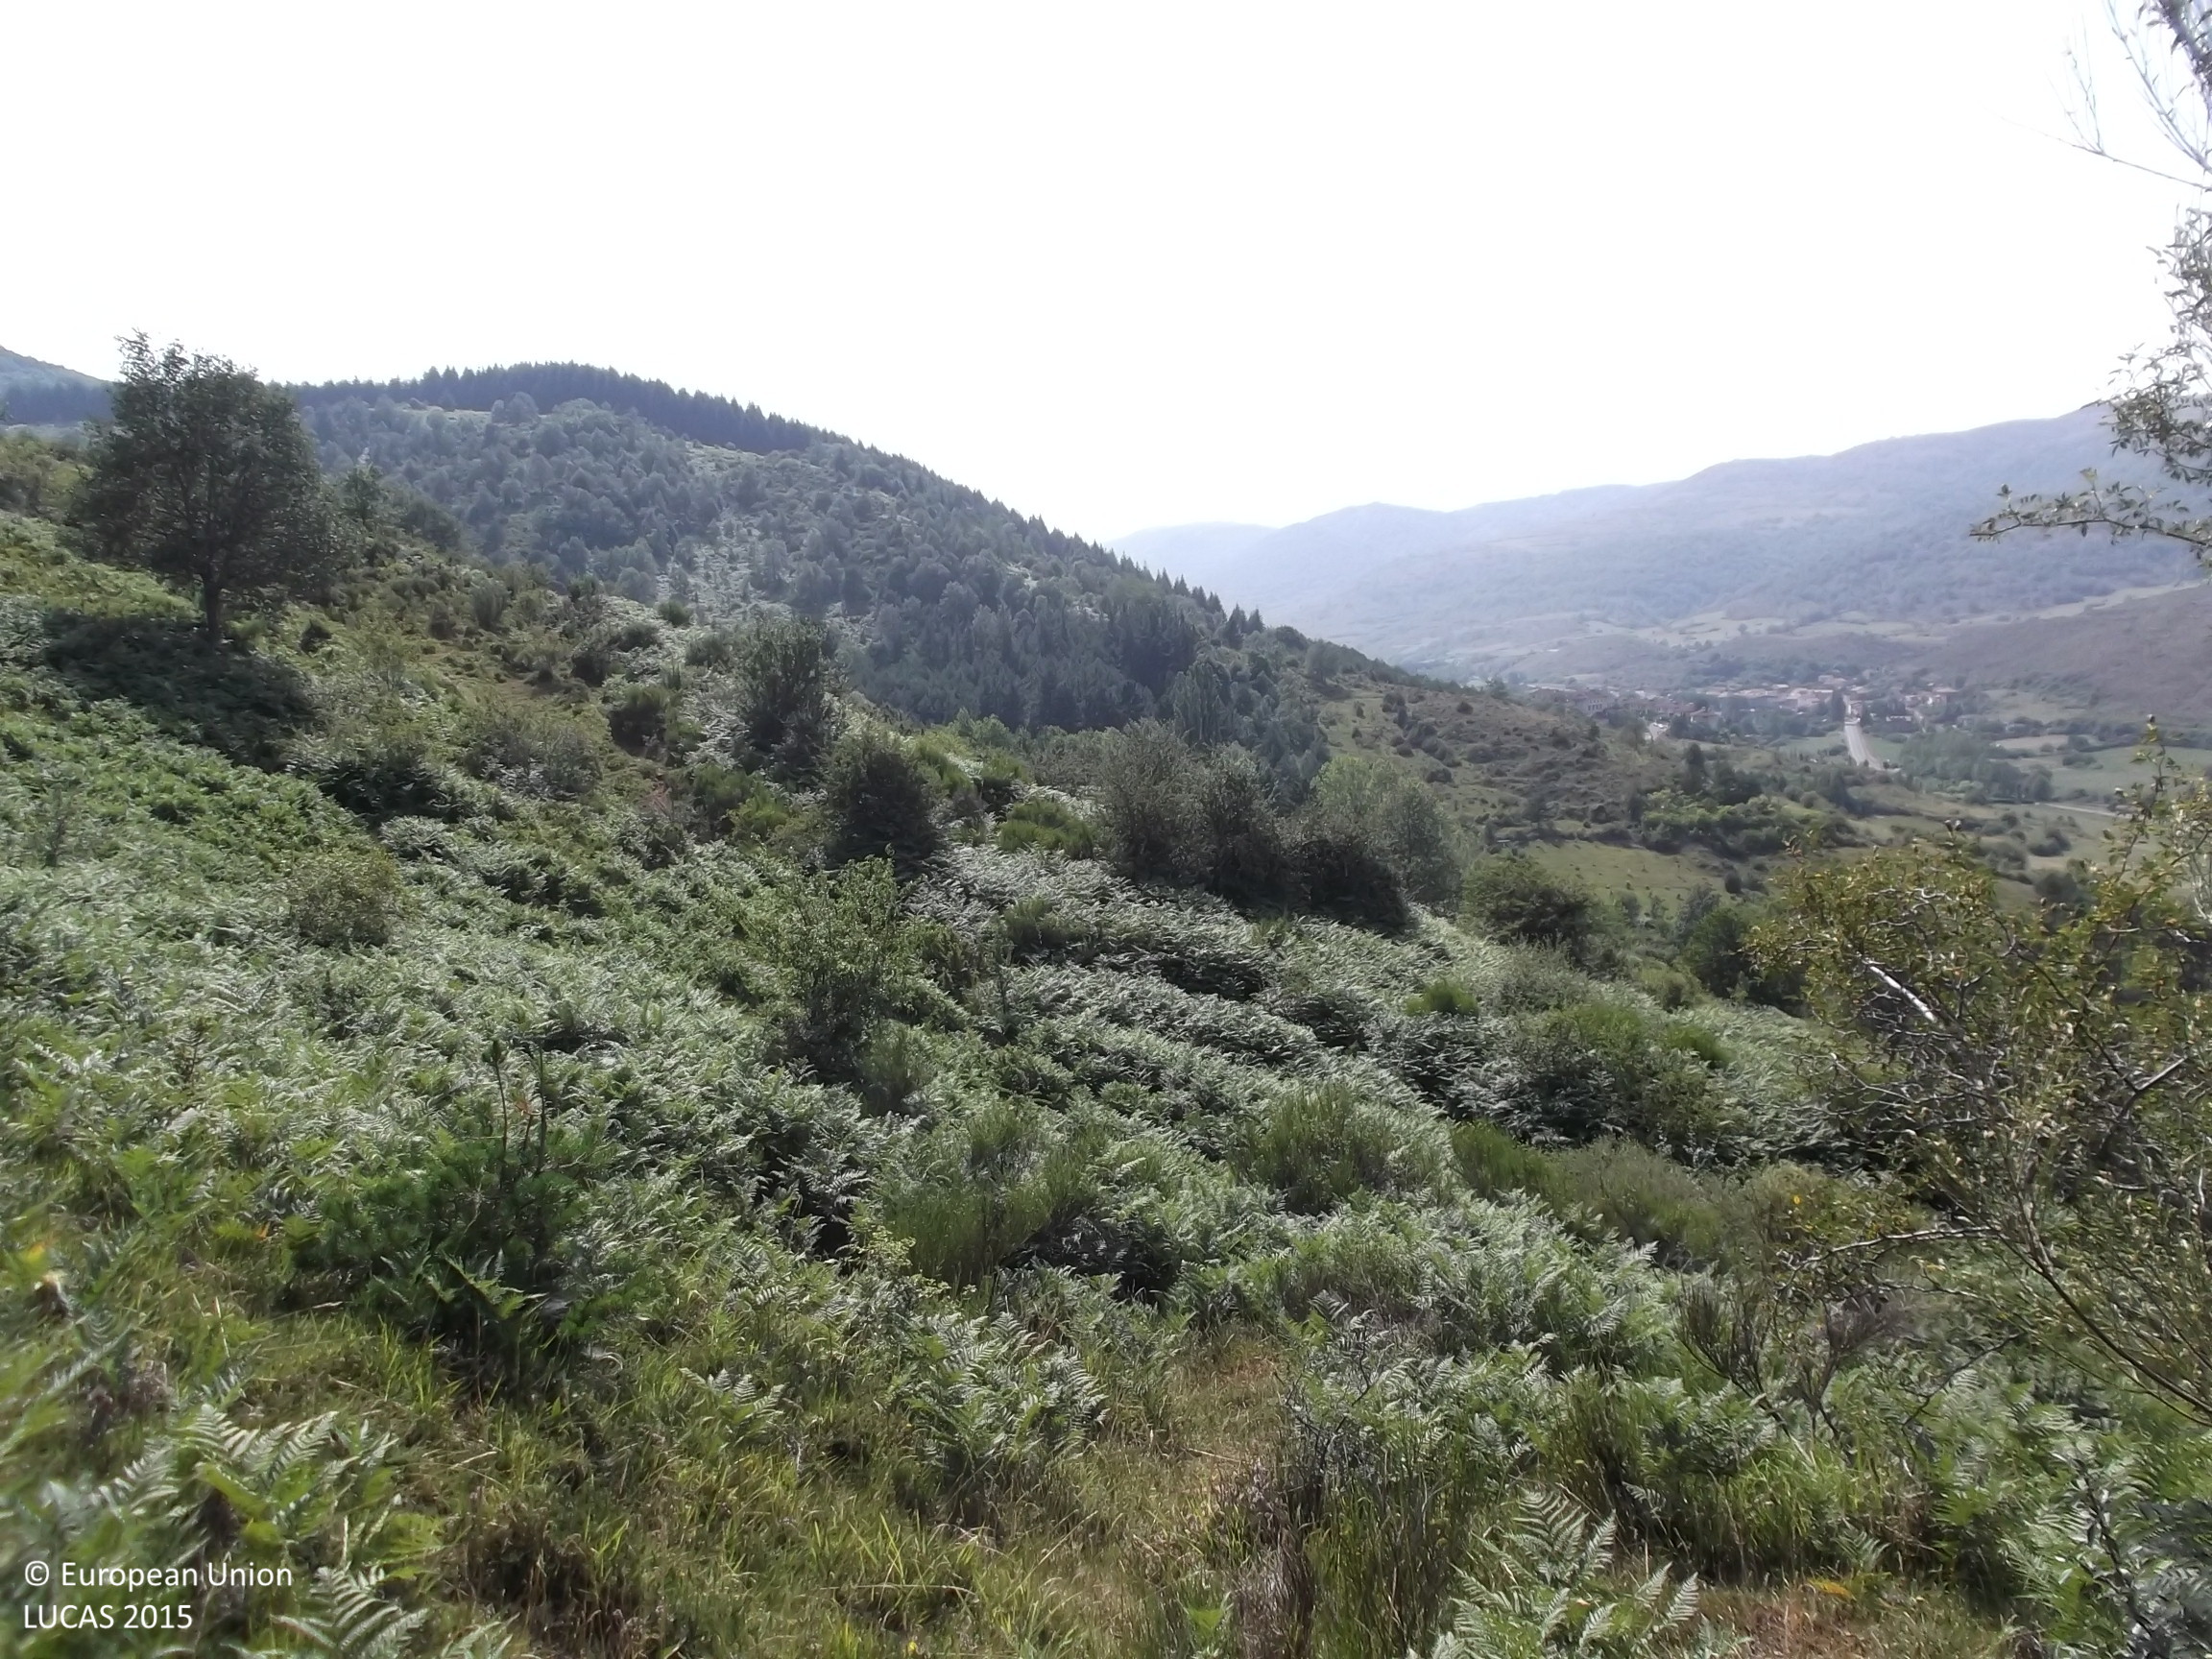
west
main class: Shrubland
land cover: Shrubland with sparse tree cover
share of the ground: > 75 %
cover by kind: shrubs 80 %, herbaceous plants 15 %, broadleaved forest trees 5 %
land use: Agriculture (excluding fallow land and kitchen gardens)
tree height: < 5 m
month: July
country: ES
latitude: 42.3210
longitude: -3.0218
